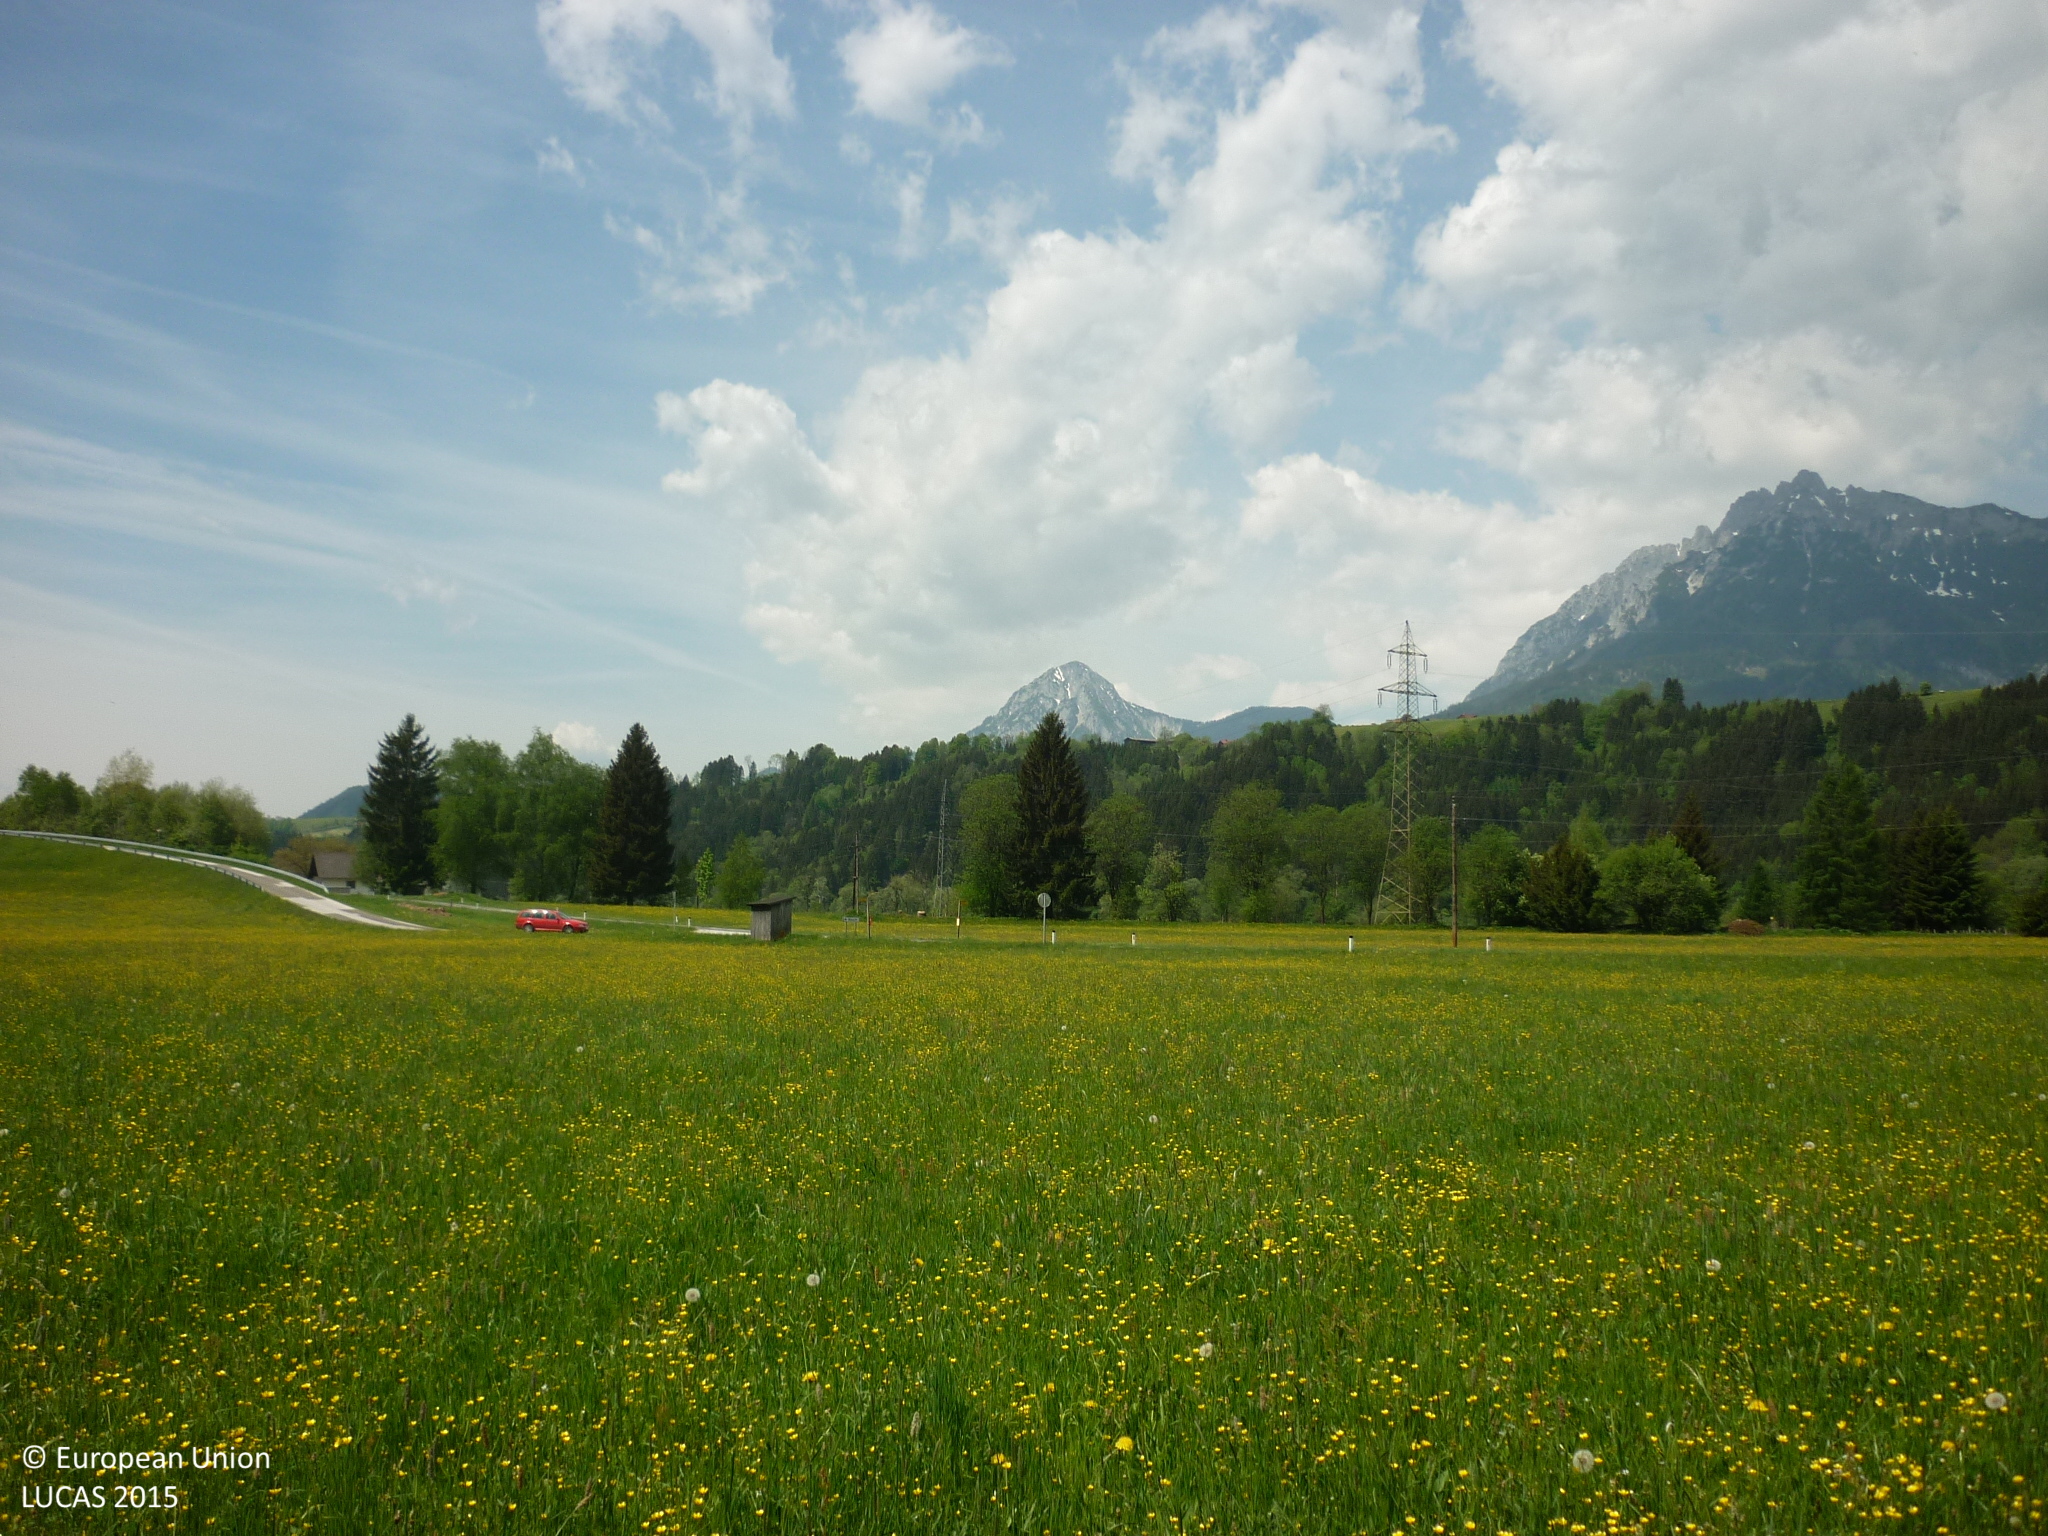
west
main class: Grassland
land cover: Grassland without tree/shrub cover
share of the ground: > 75 %
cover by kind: herbaceous plants 100 %
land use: Agriculture (excluding fallow land and kitchen gardens)
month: May
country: AT
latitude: 47.4496
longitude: 13.9641
